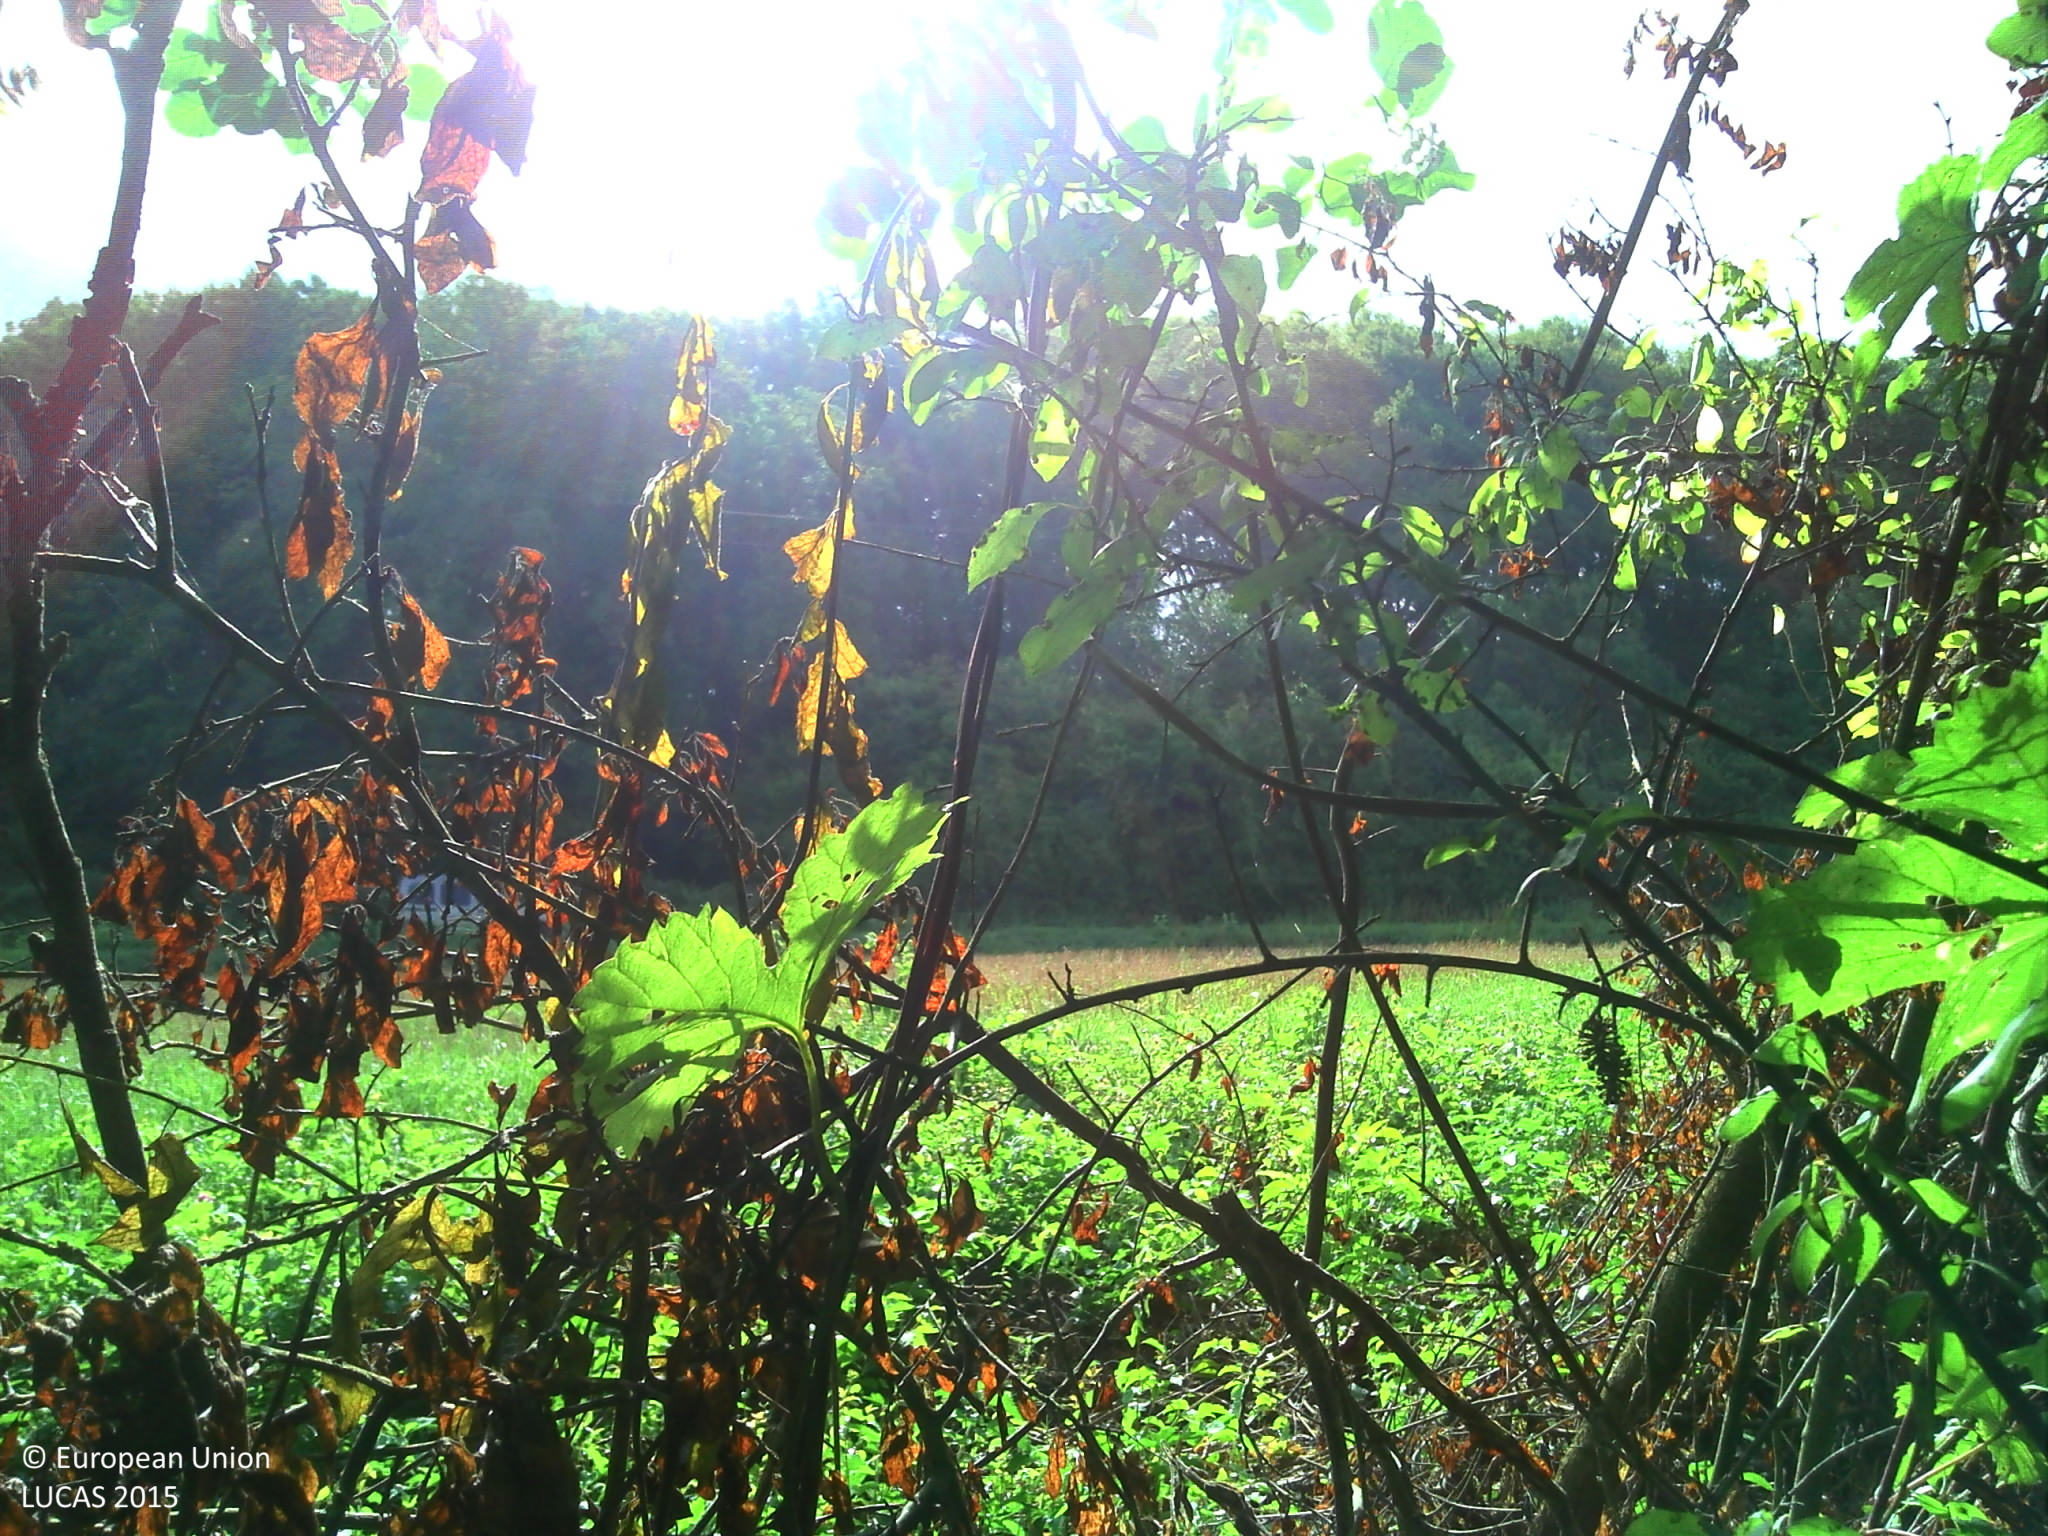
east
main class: Woodland
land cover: Broadleaved woodland
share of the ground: > 75 %
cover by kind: broadleaved forest trees 95 %, herbaceous plants 5 %
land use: Semi-natural and natural areas not in use
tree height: > 5 m
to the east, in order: Broadleaved woodland; Inland fresh running water; Broadleaved woodland; Spontaneously vegetated surfaces; Grassland without tree/shrub cover; Other bare soil; Spontaneously vegetated surfaces; Tracks; Grass margins; Ditches and canals; Fences; Grassland without tree/shrub cover; Fences; Broadleaved woodland; Ditches and canals; Broadleaved woodland; Grassland without tree/shrub cover; Other bare soil
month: July
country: FR
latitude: 49.2116
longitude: 5.0423
